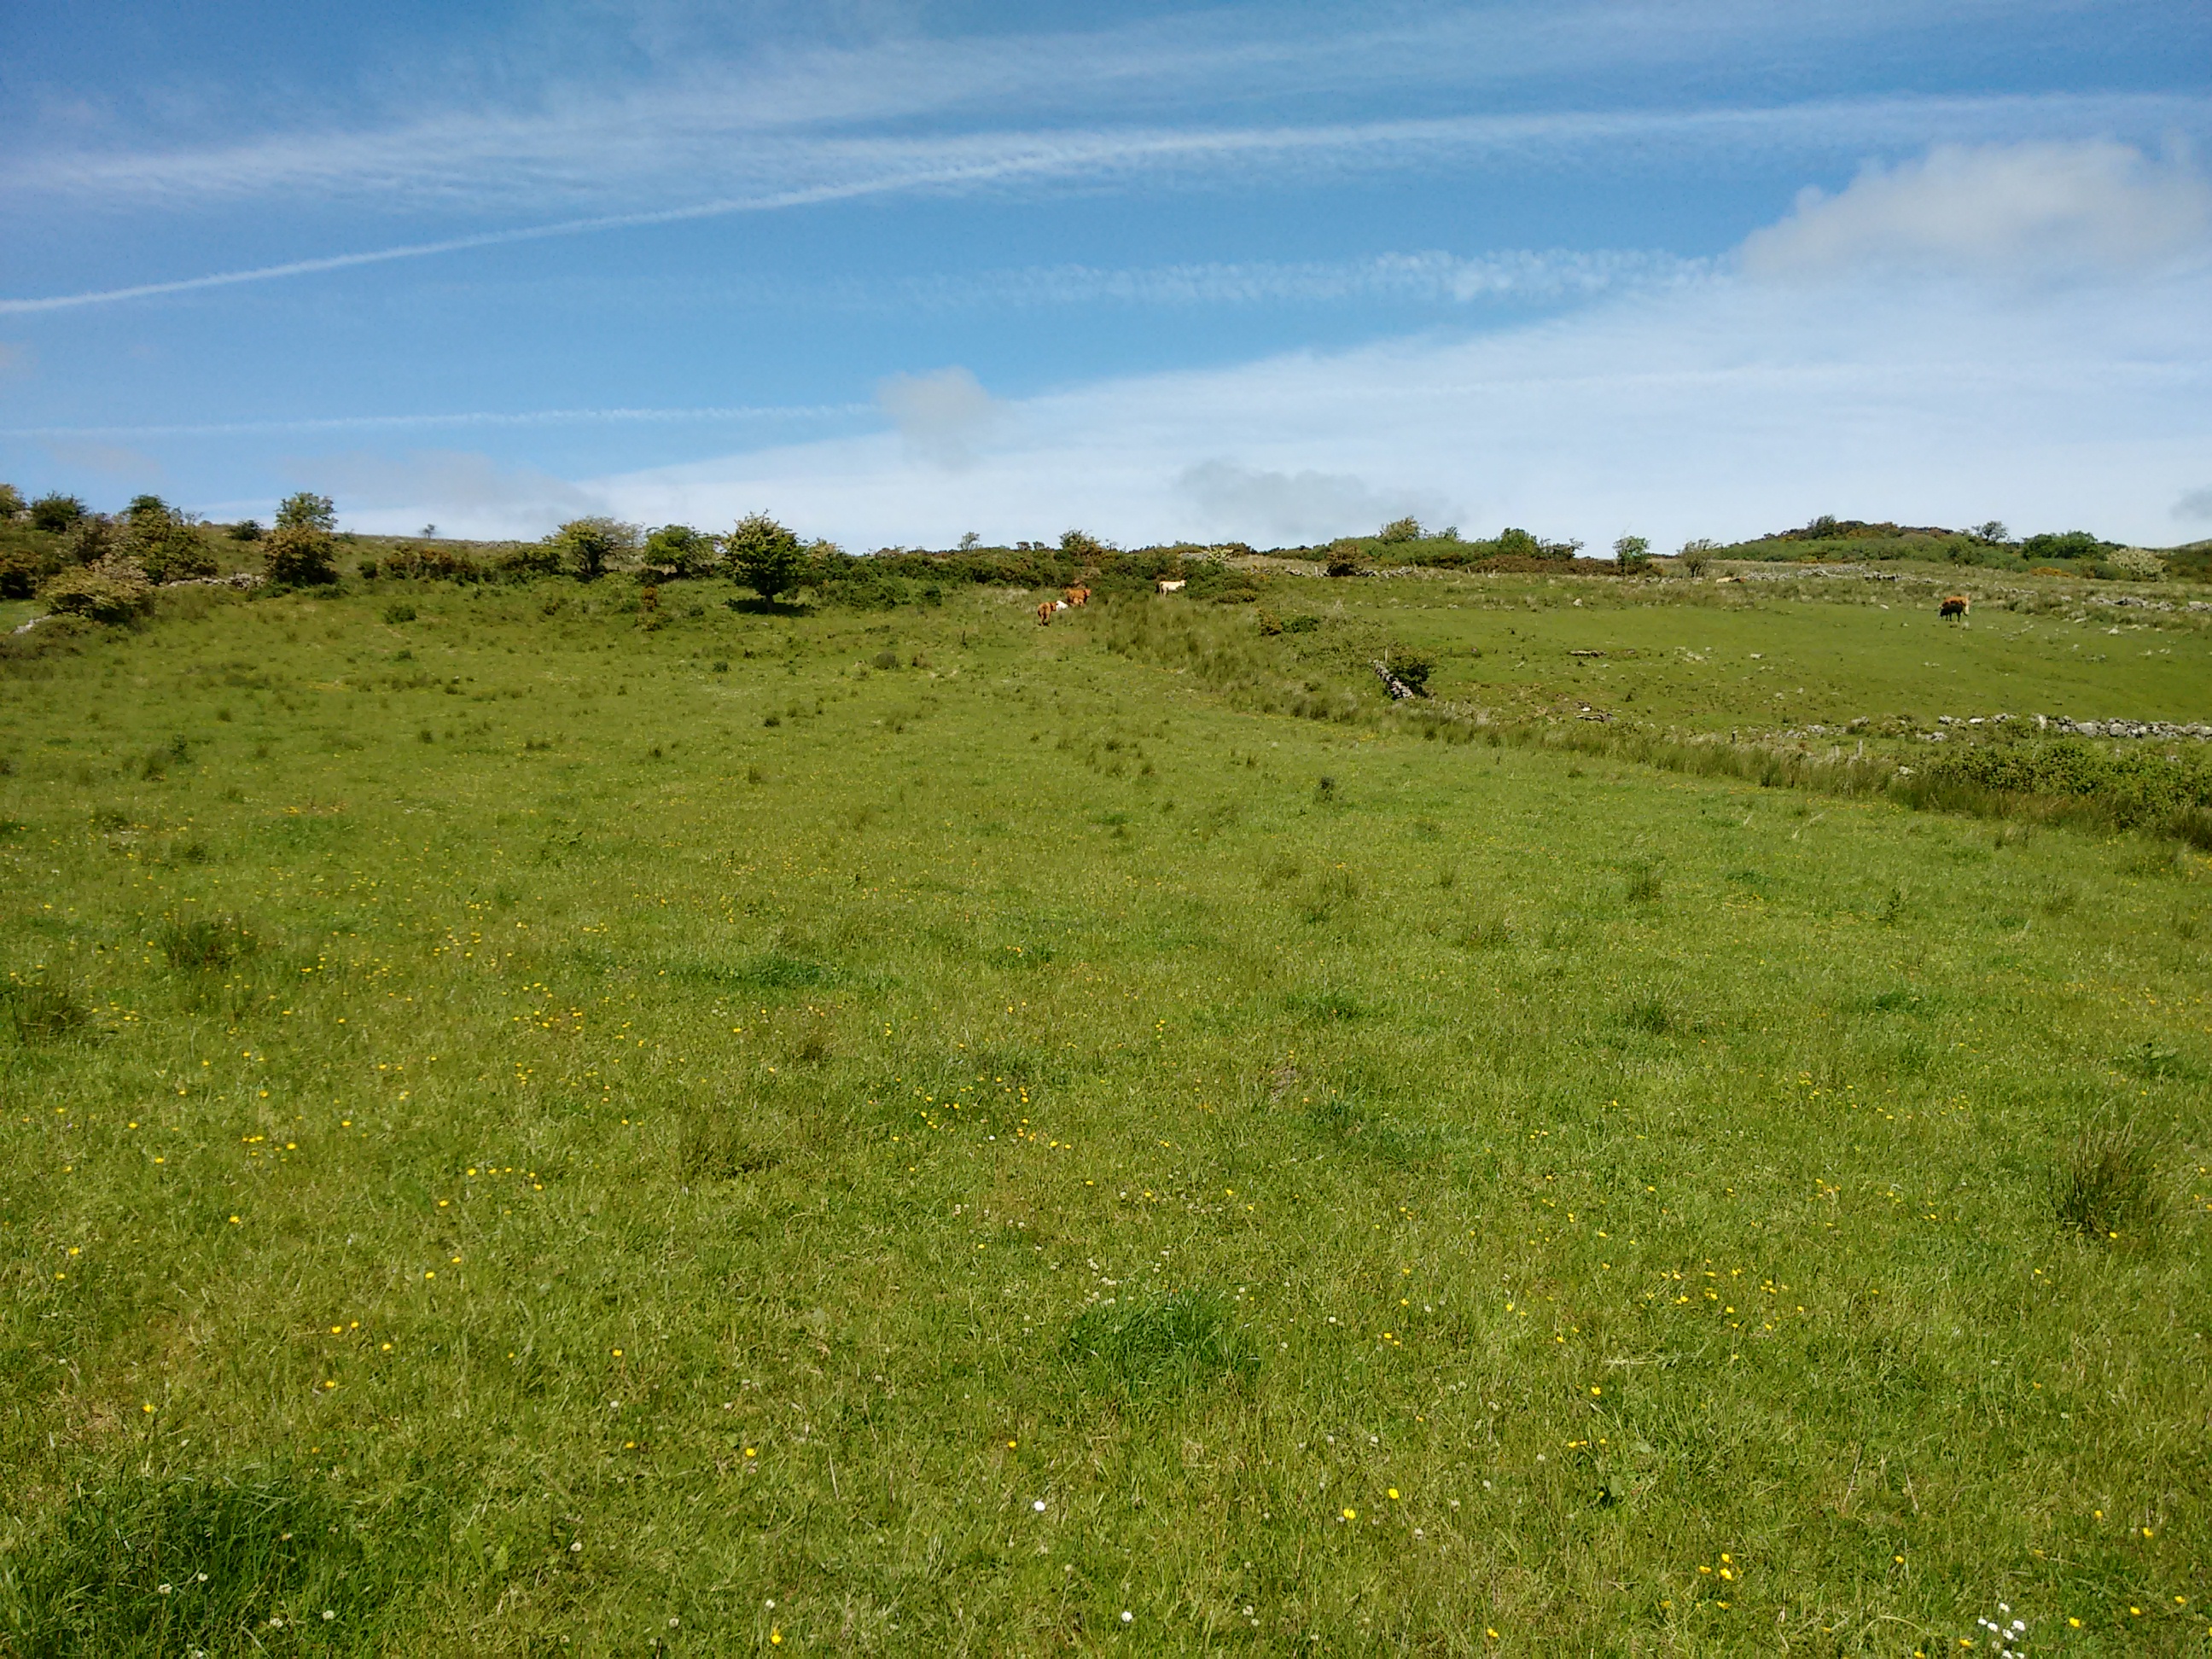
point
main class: Grassland
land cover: Grassland without tree/shrub cover
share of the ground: > 75 %
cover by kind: herbaceous plants 100 %
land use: Agriculture (excluding fallow land and kitchen gardens)
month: June
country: IE
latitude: 53.1521
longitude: -8.5428
